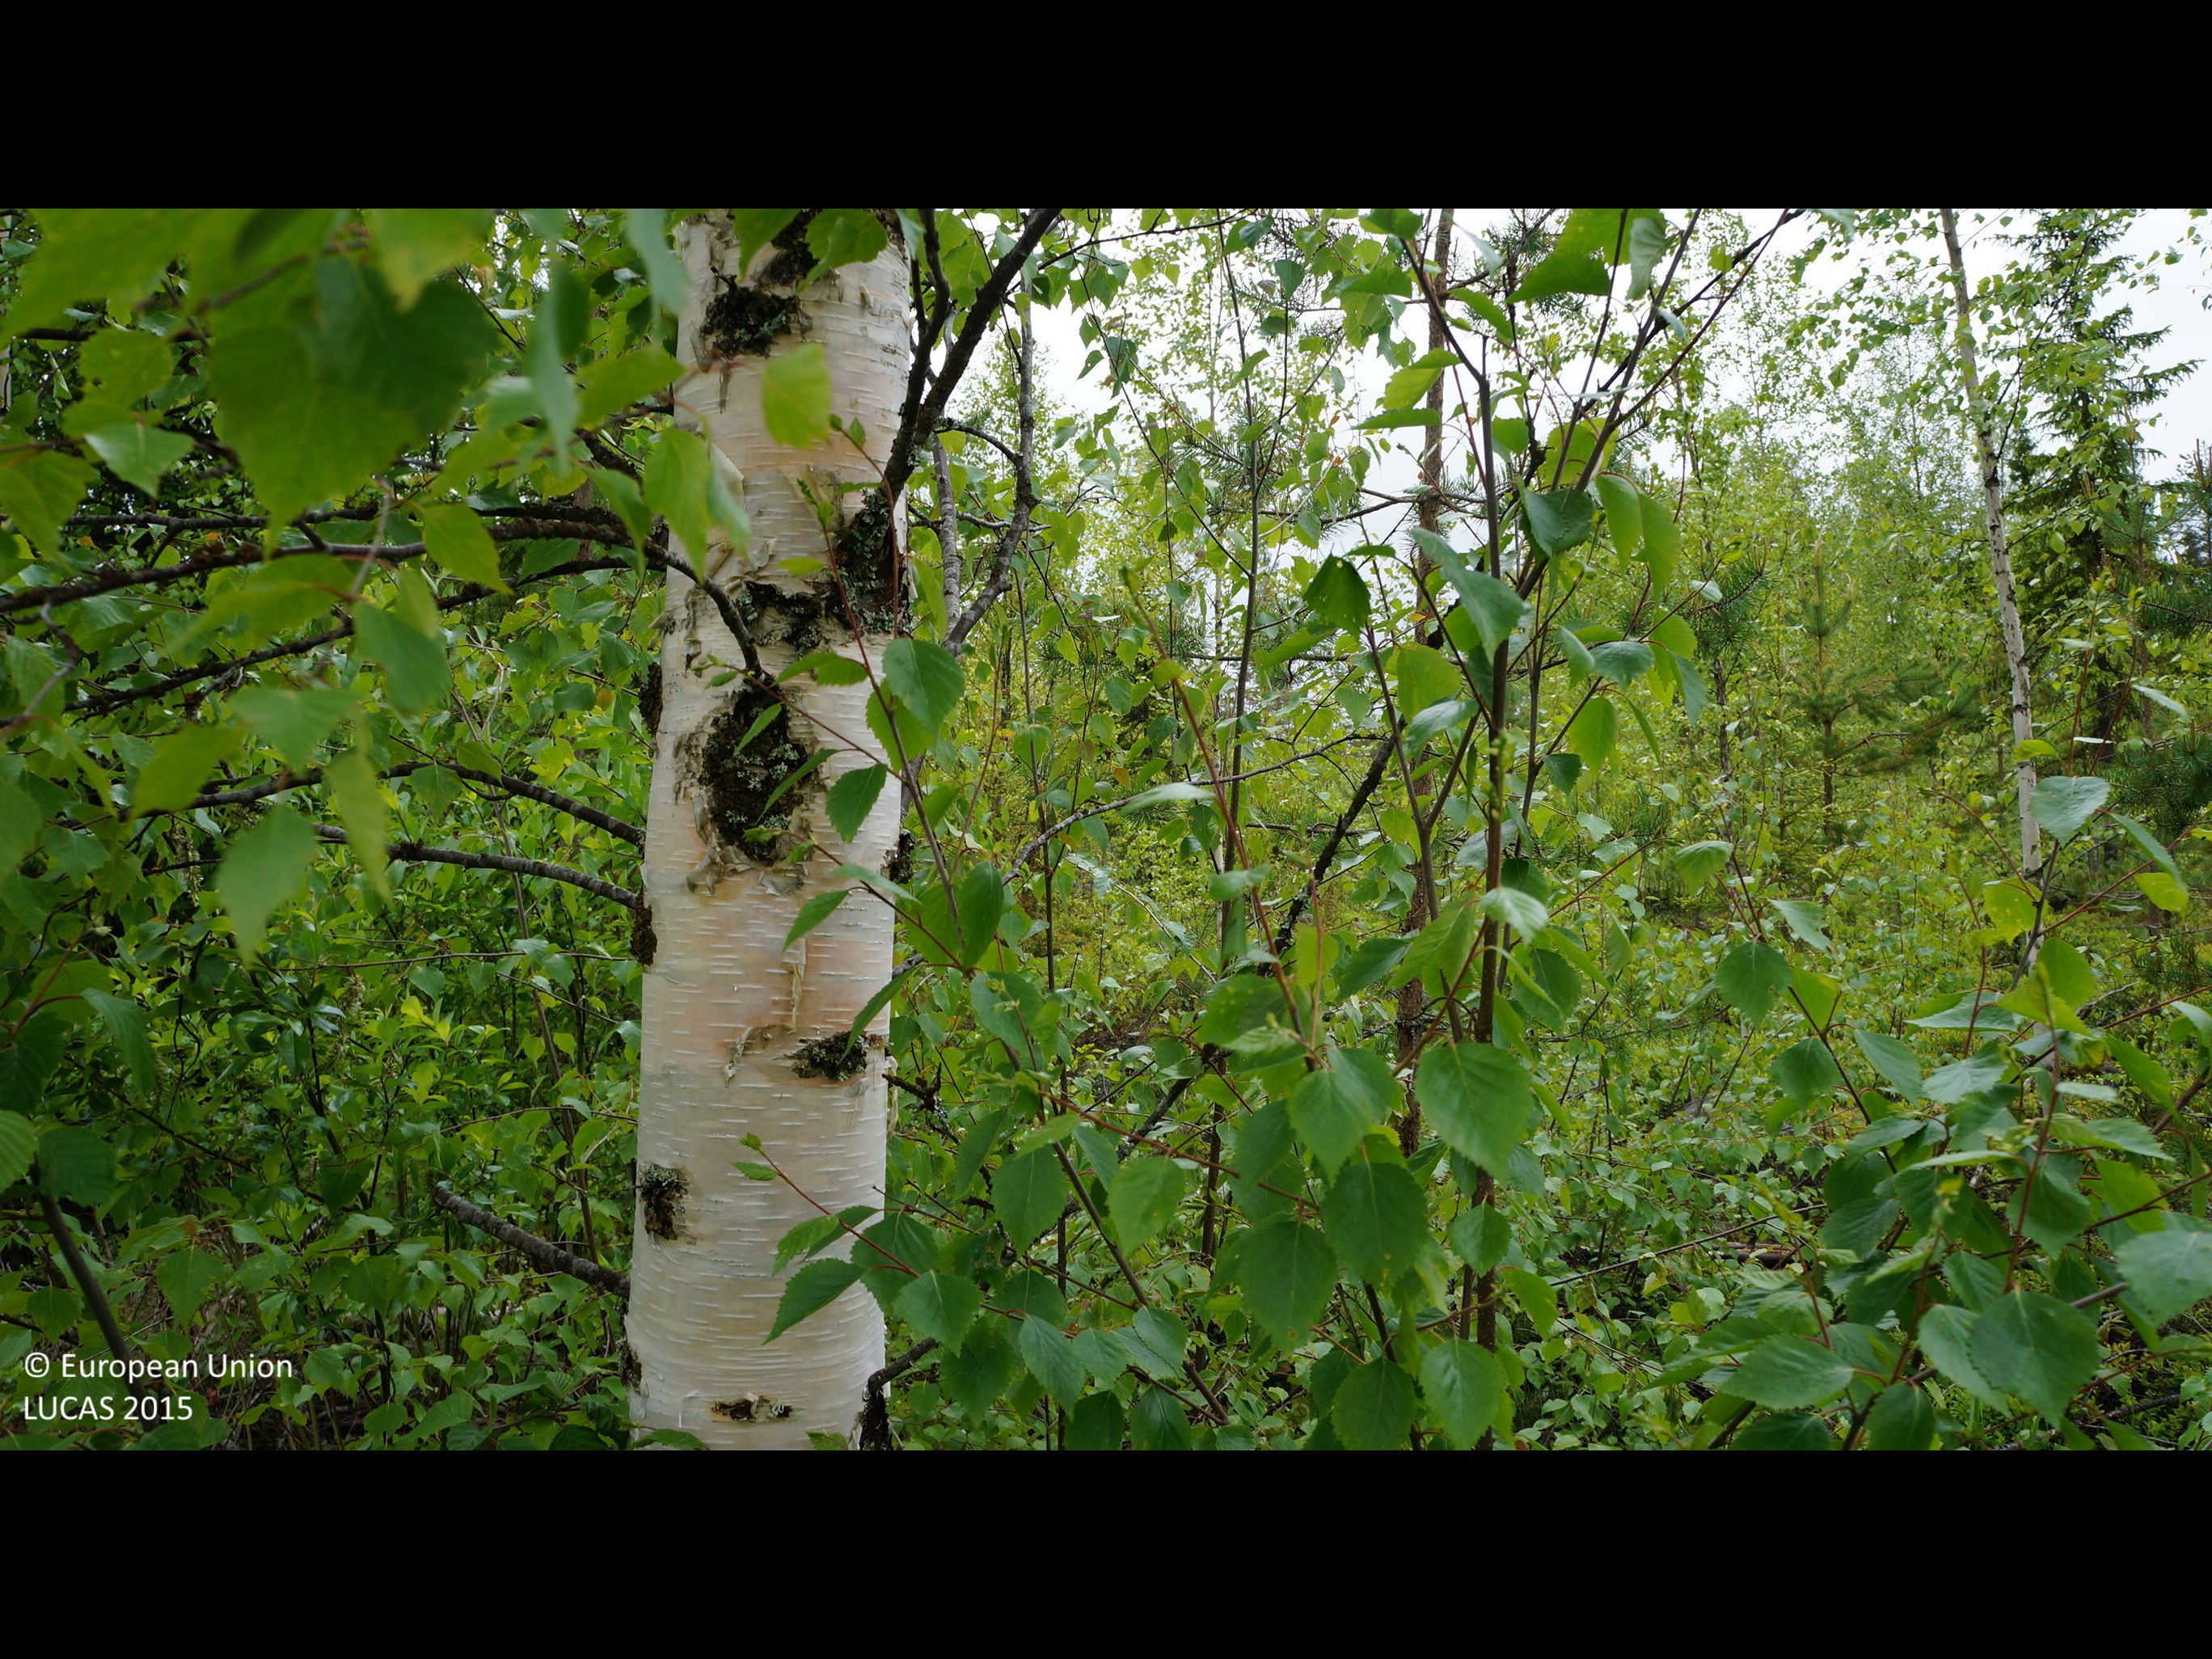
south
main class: Woodland
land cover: Pine dominated mixed woodland
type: boreal forest
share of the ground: 25 - 50 %
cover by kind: shrubs 35 %, broadleaved forest trees 25 %, coniferous forest trees 20 %, herbaceous plants 10 %, lichens and mosses 10 %
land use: Forestry
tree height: > 5 m
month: June
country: FI
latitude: 63.8929
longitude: 24.8912
